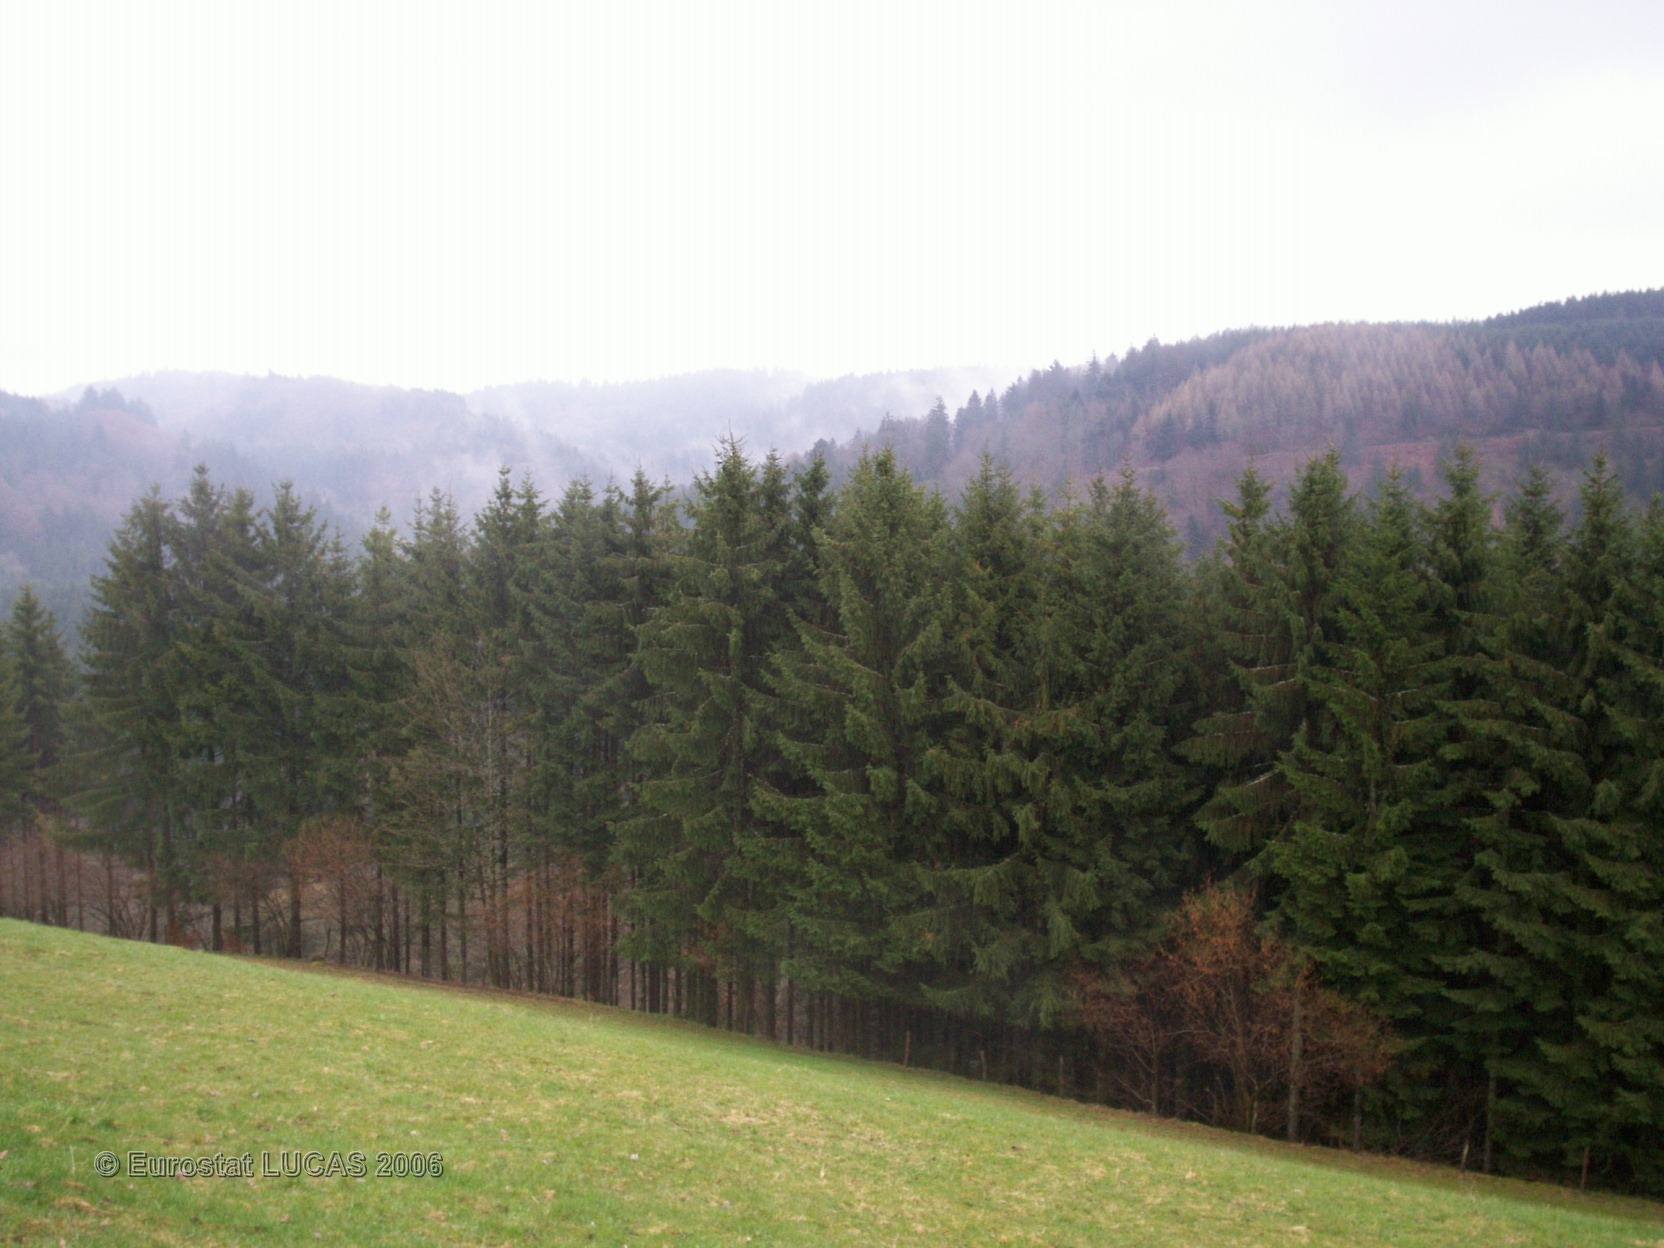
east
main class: Grassland
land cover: Grassland without tree/shrub cover
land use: Agriculture (excluding fallow land and kitchen gardens)
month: April
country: FR
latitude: 47.9358
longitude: 6.5609
